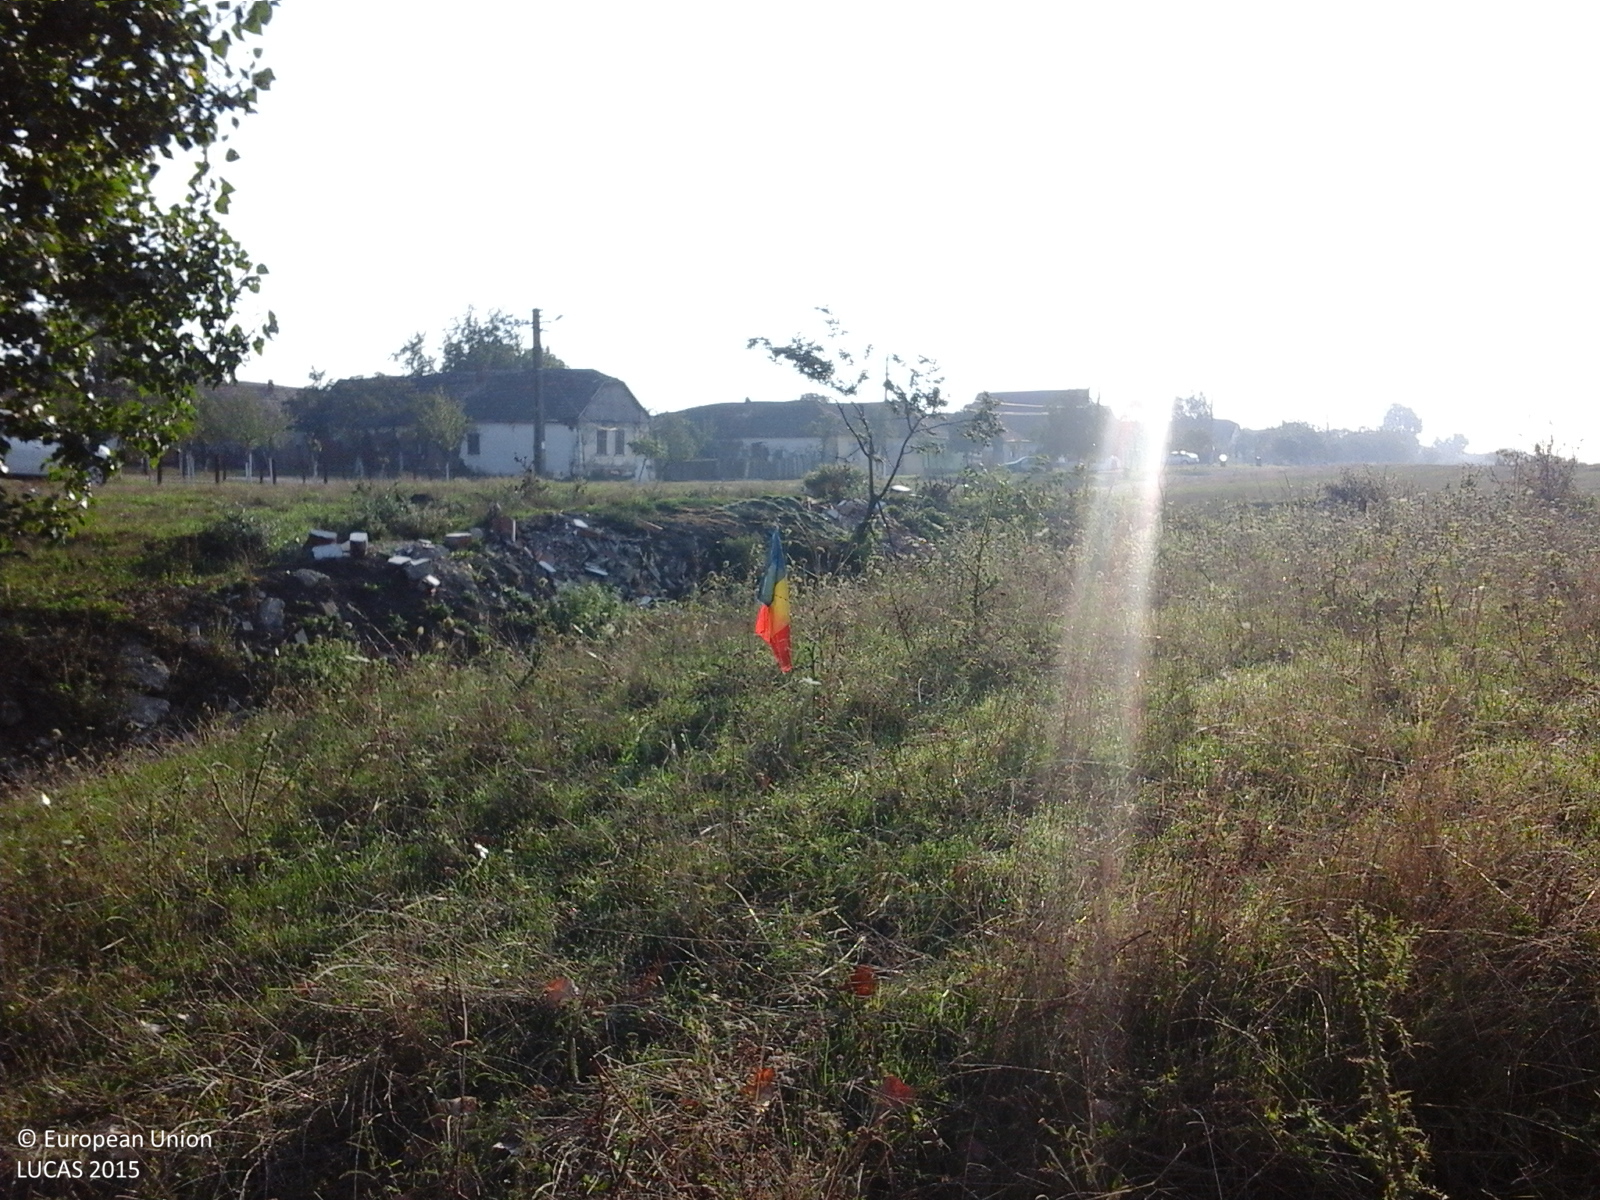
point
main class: Grassland
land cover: Grassland without tree/shrub cover
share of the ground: > 75 %
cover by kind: herbaceous plants 100 %
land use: Agriculture (excluding fallow land and kitchen gardens)
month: August
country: RO
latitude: 46.0971
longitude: 21.4568
